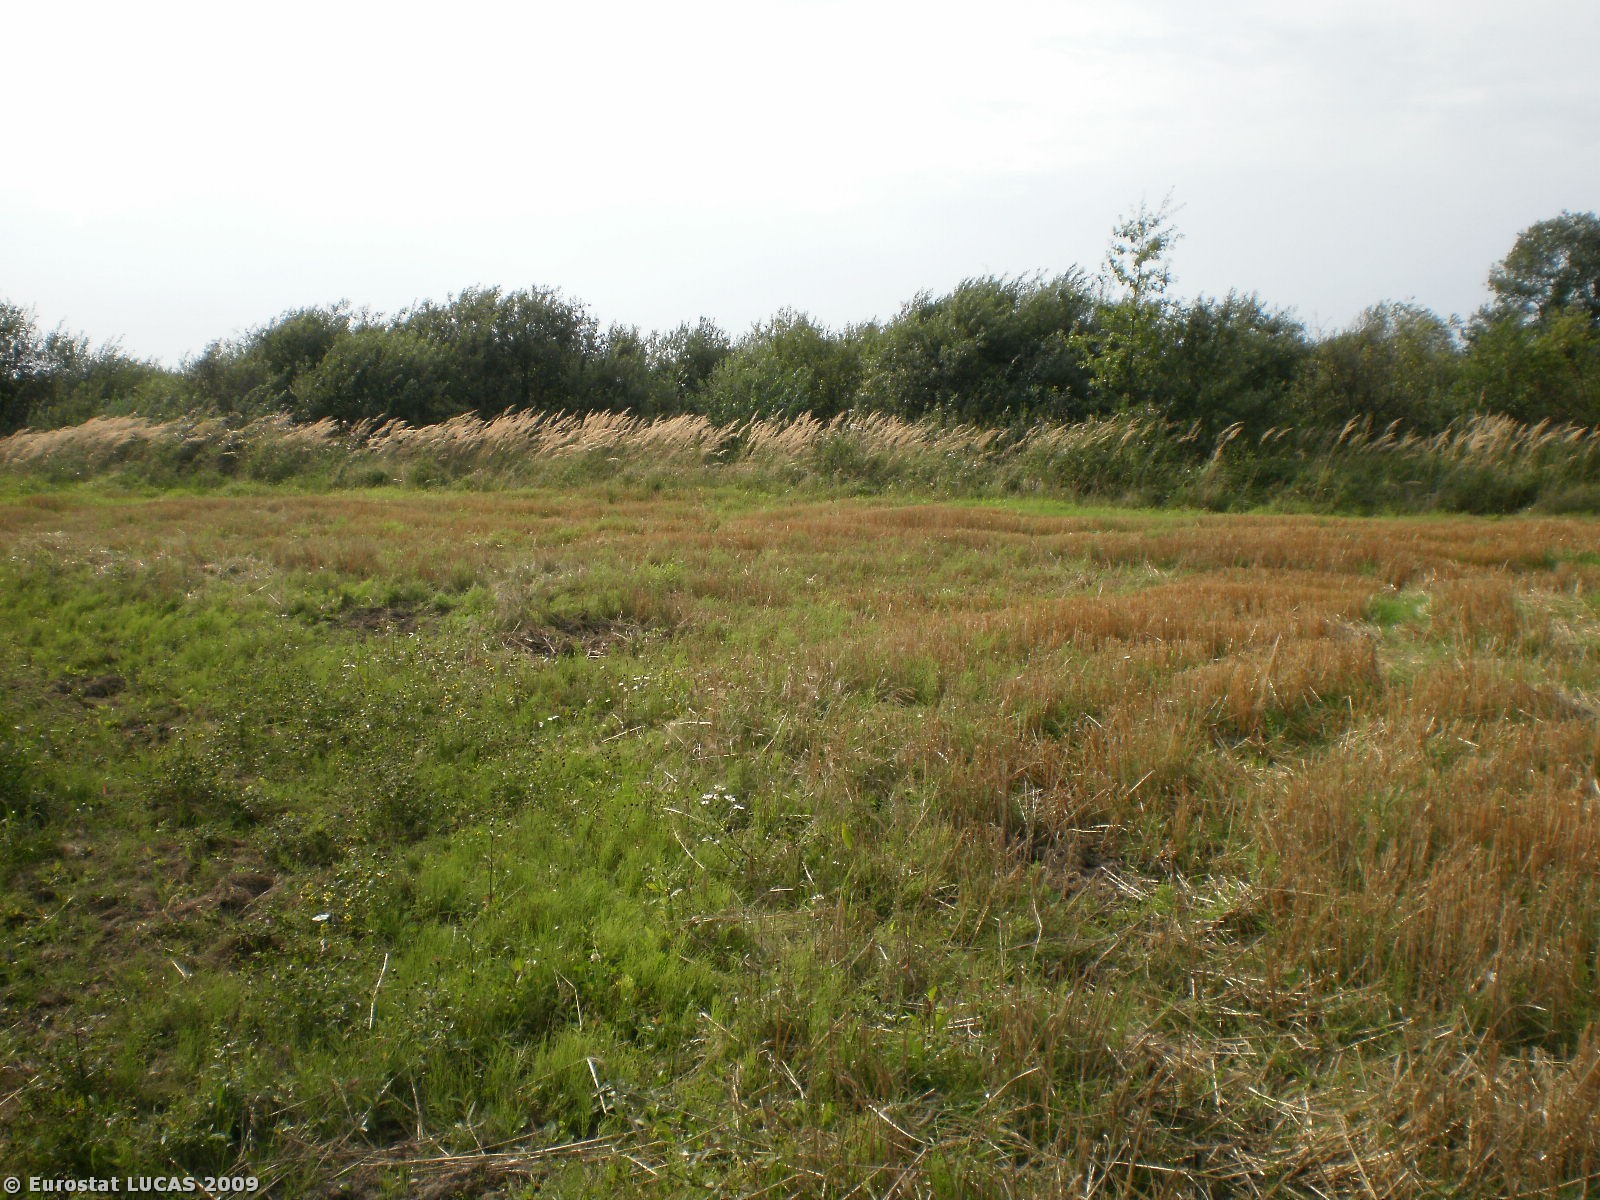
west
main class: Cropland
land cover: Triticale
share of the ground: < 10 %
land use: Agriculture (excluding fallow land and kitchen gardens)
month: September
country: PL
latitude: 53.9281
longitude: 21.4557
